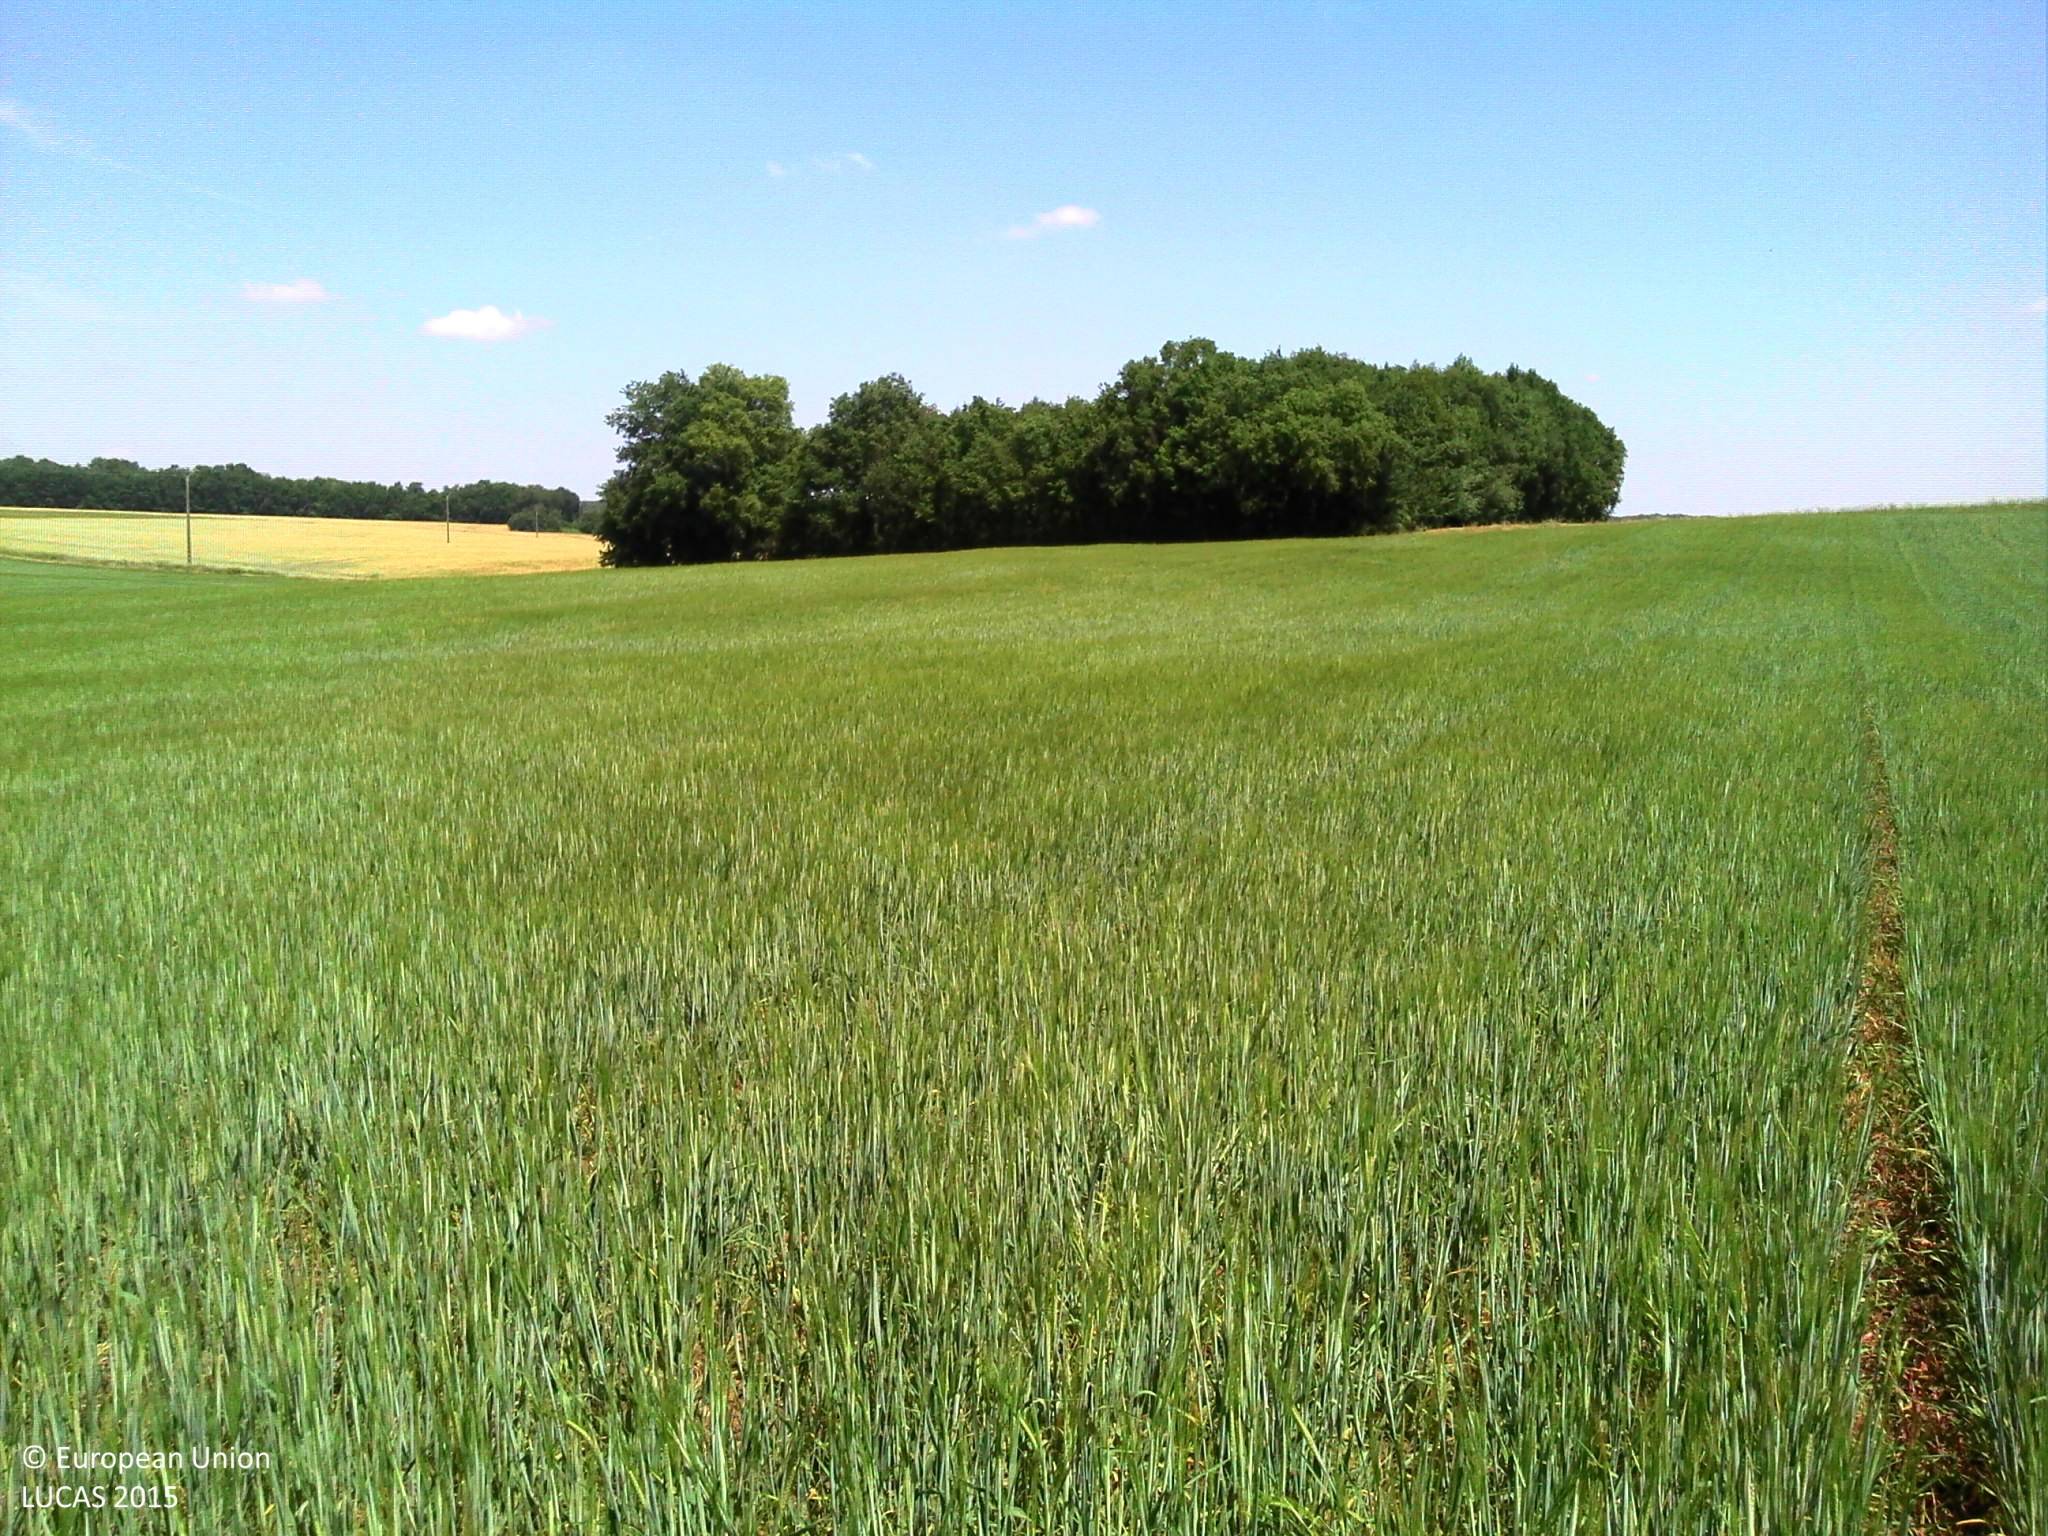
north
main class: Cropland
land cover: Barley
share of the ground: > 75 %
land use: Agriculture (excluding fallow land and kitchen gardens)
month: June
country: FR
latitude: 46.5175
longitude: 0.6116
